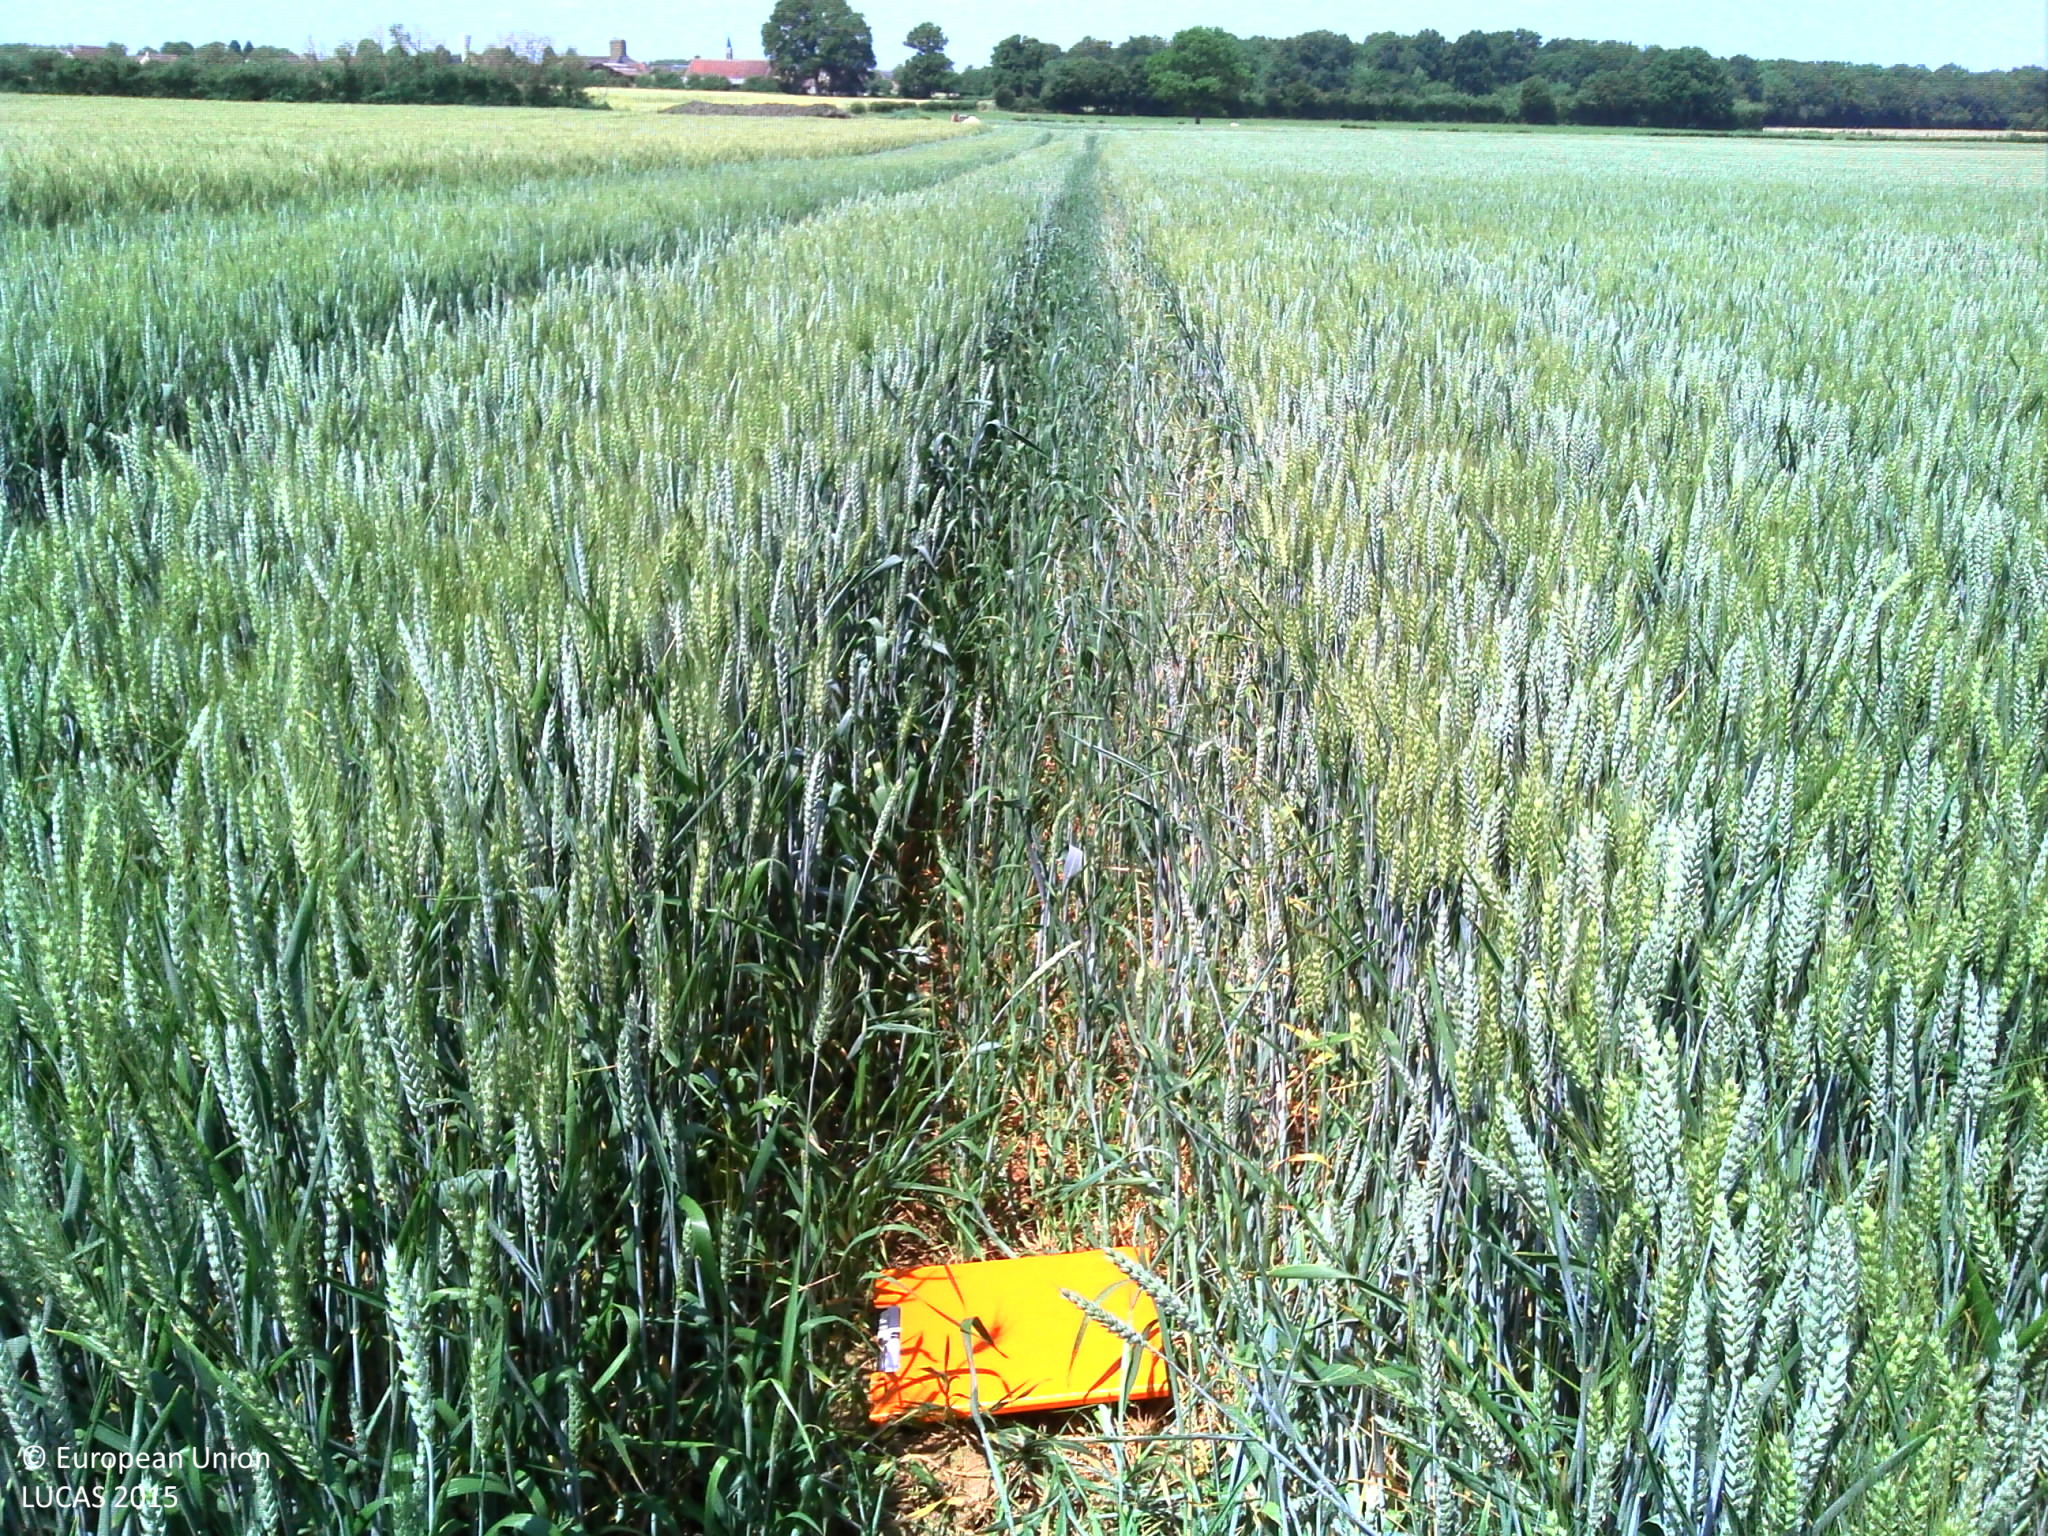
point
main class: Cropland
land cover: Common wheat
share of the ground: > 75 %
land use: Agriculture (excluding fallow land and kitchen gardens)
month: June
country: FR
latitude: 46.9694
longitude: 2.6998
